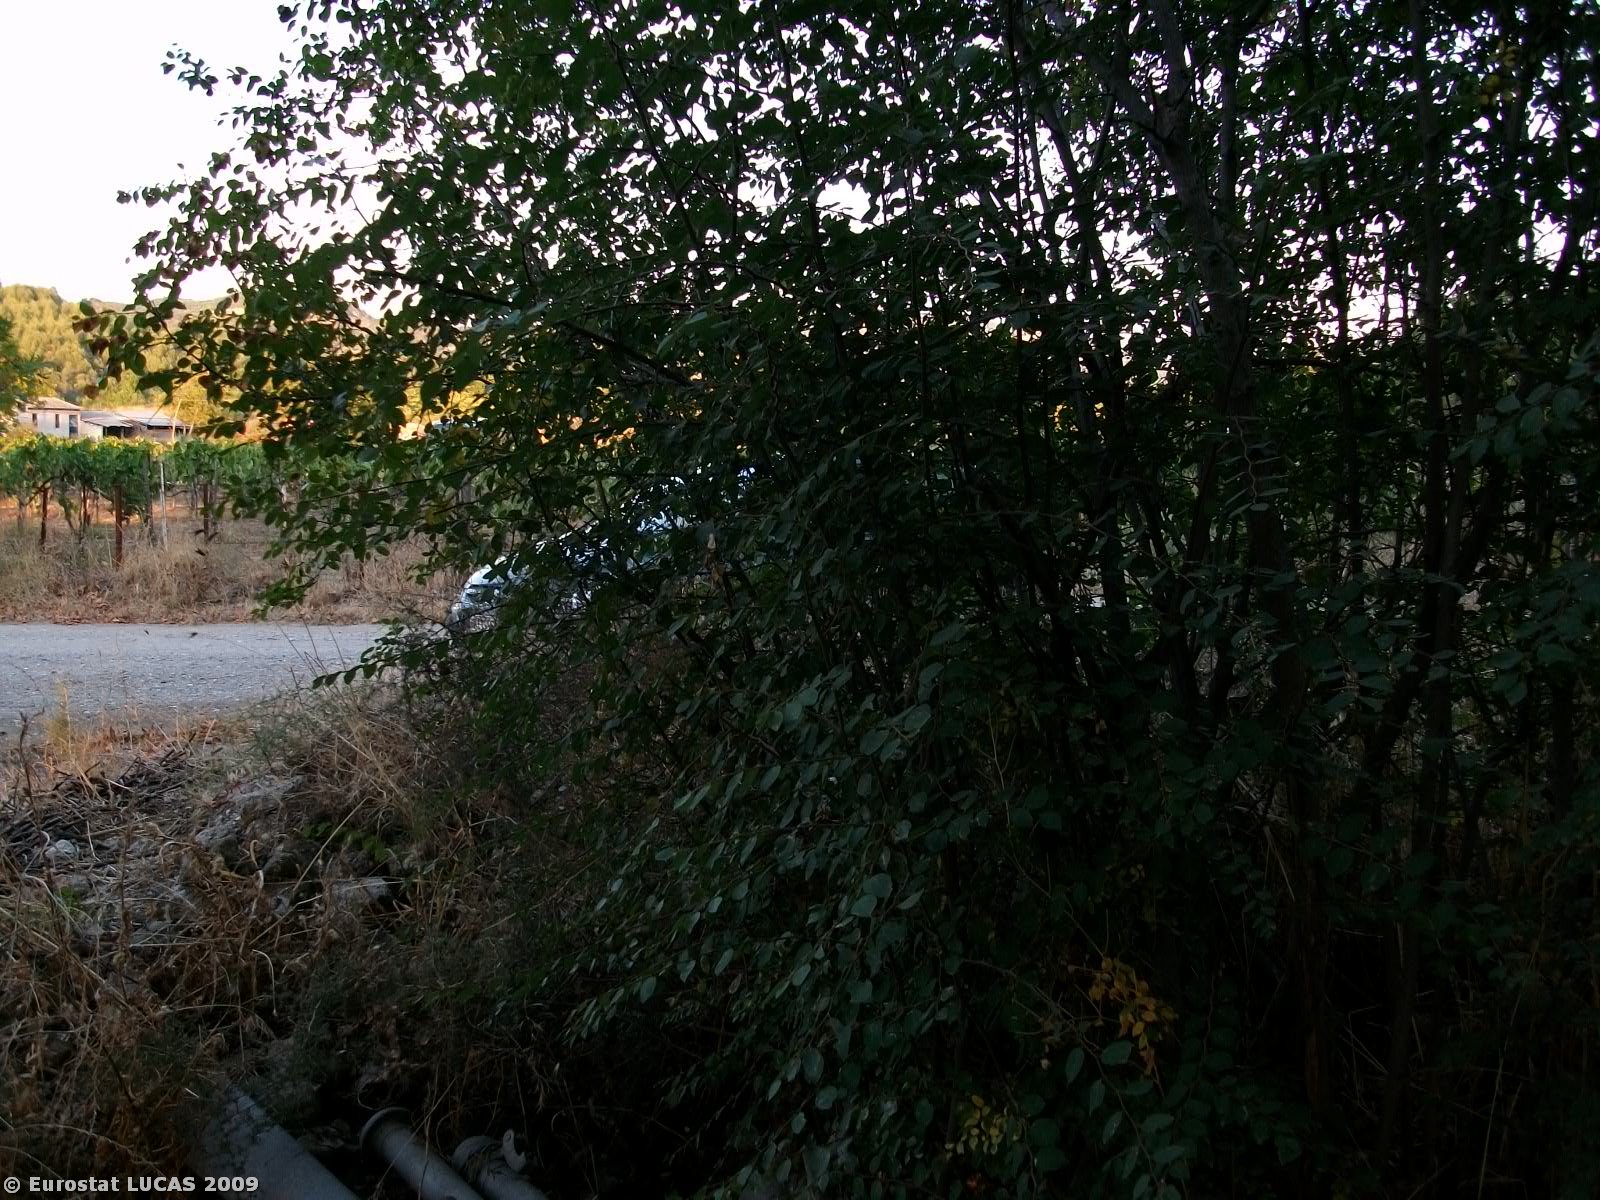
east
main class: Shrubland
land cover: Shrubland with sparse tree cover
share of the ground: 50 - 75 %
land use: Unused
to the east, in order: Shrubland with sparse tree cover; Paved roads, cycling and walking lanes; Fences; Vineyards; Grassland with sparse tree/shrub cover; Ditches and canals; Bare land; Electric lines; Spontaneously vegetated surfaces; Broadleaved woodland; Paved roads, cycling and walking lanes; Shrubland with sparse tree cover; Spontaneously vegetated surfaces
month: August
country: GR
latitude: 38.9352
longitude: 23.1740
